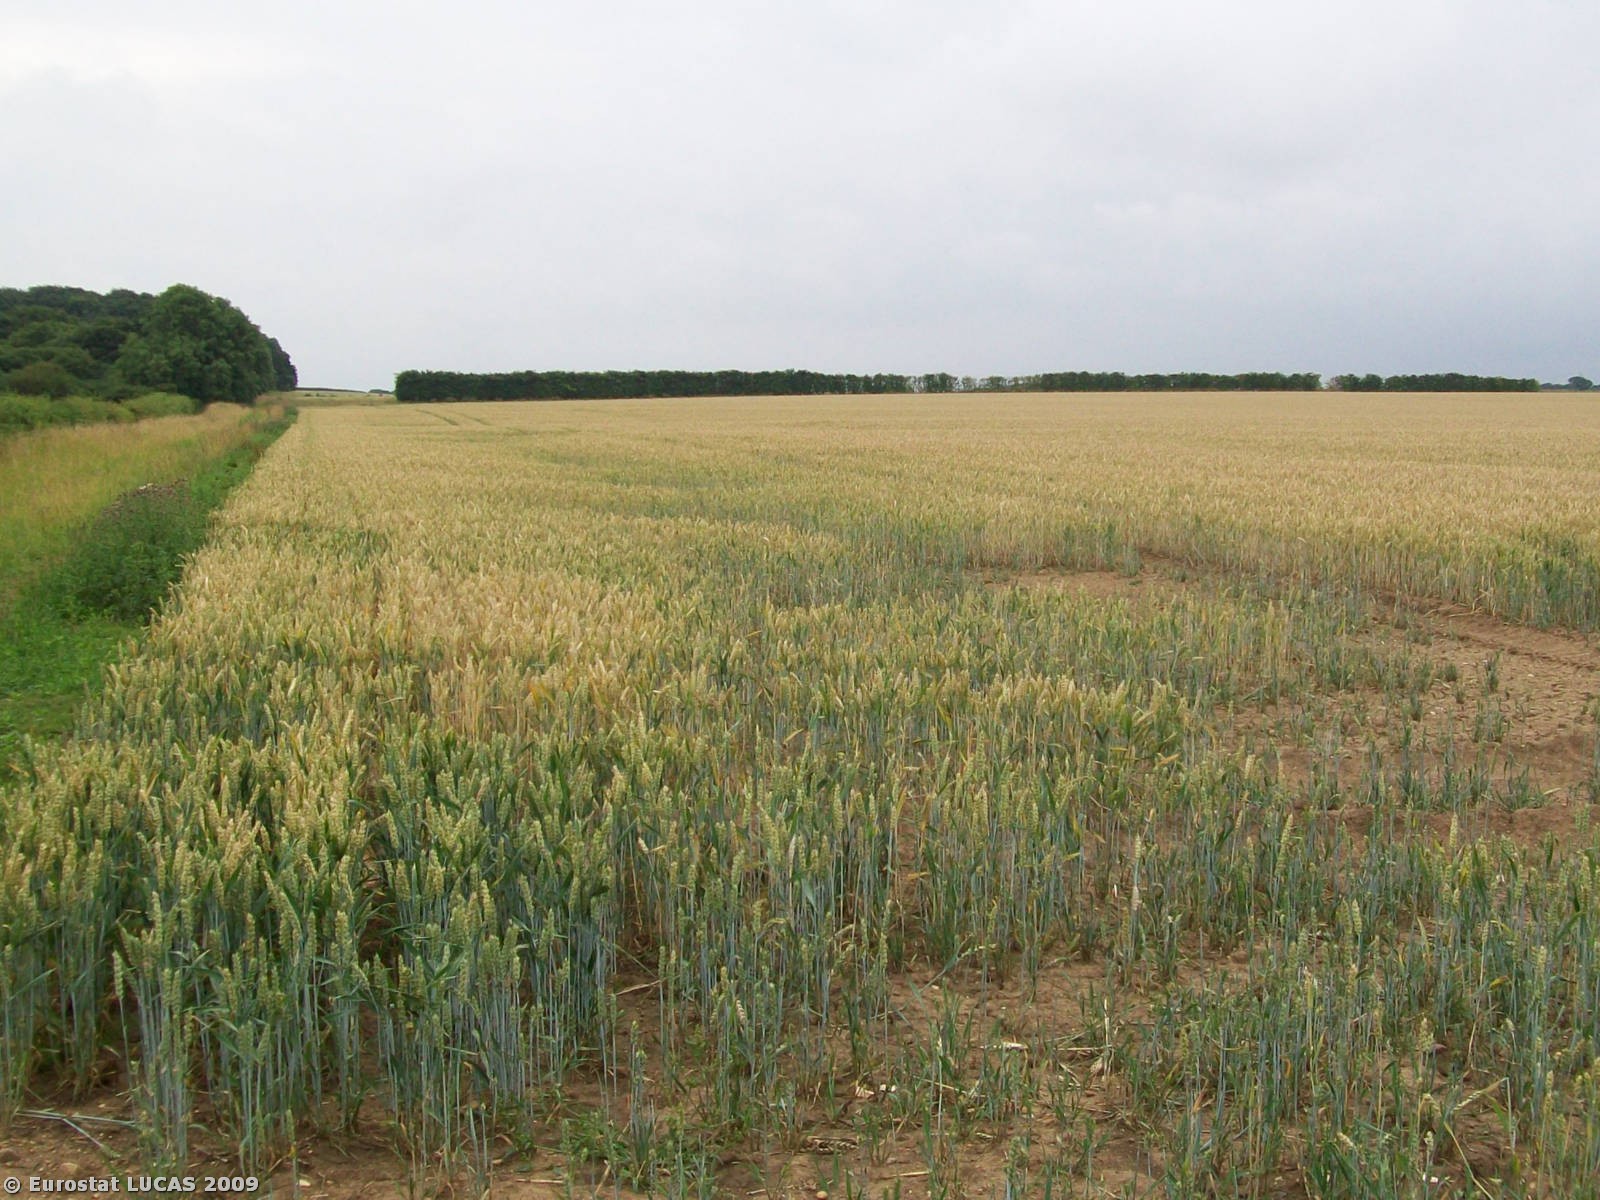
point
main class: Cropland
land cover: Common wheat
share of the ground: > 75 %
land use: Agriculture (excluding fallow land and kitchen gardens)
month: July
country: GB
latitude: 53.8706
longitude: -0.2694
